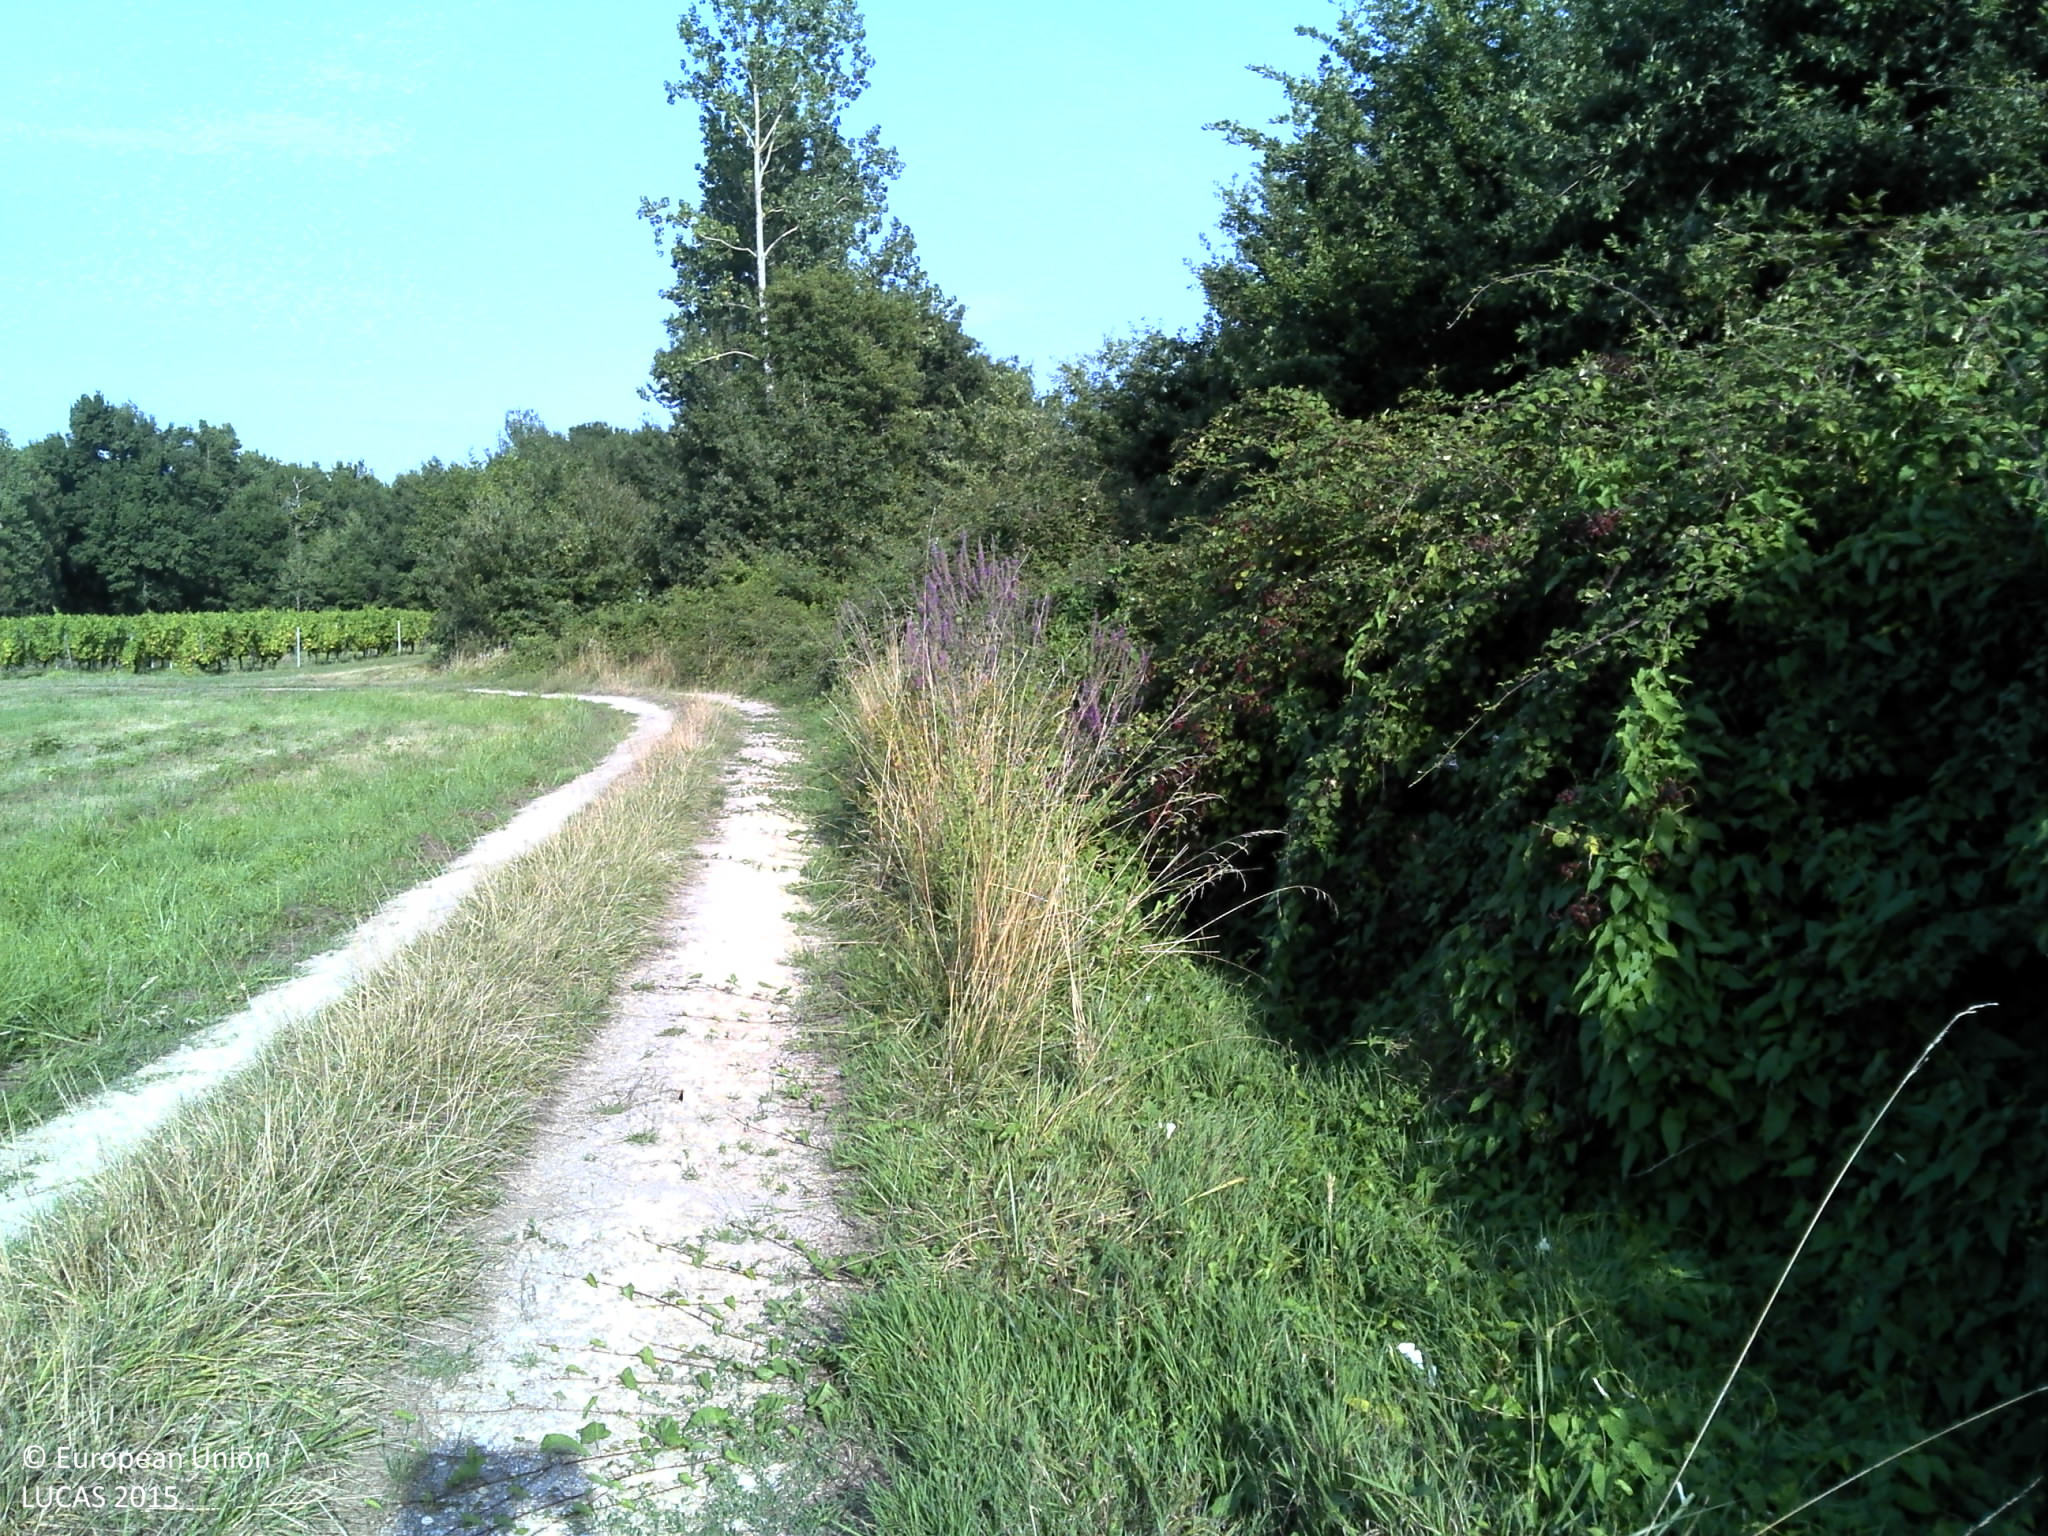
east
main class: Shrubland
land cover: Shrubland with sparse tree cover
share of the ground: > 75 %
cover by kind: shrubs 90 %, broadleaved forest trees 5 %, herbaceous plants 5 %
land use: Semi-natural and natural areas not in use
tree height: > 5 m
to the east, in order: Shrubland with sparse tree cover; Broadleaved woodland; Other fresh vegetables; Ditches and canals; Fences; Grassland without tree/shrub cover; Fences; Broadleaved woodland; Fences; Ditches and canals; Broadleaved woodland; Ditches and canals; Broadleaved woodland
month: August
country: FR
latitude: 45.2588
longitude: -0.6110
